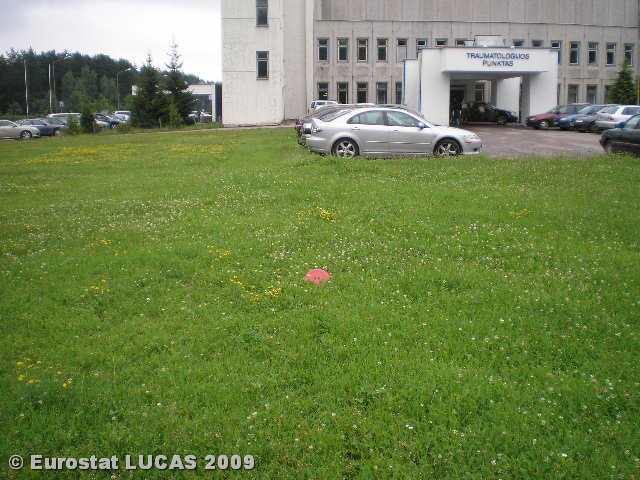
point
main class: Grassland
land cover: Grassland without tree/shrub cover
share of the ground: > 75 %
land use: Community services
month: July
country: LT
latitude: 54.6688
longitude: 25.2062
